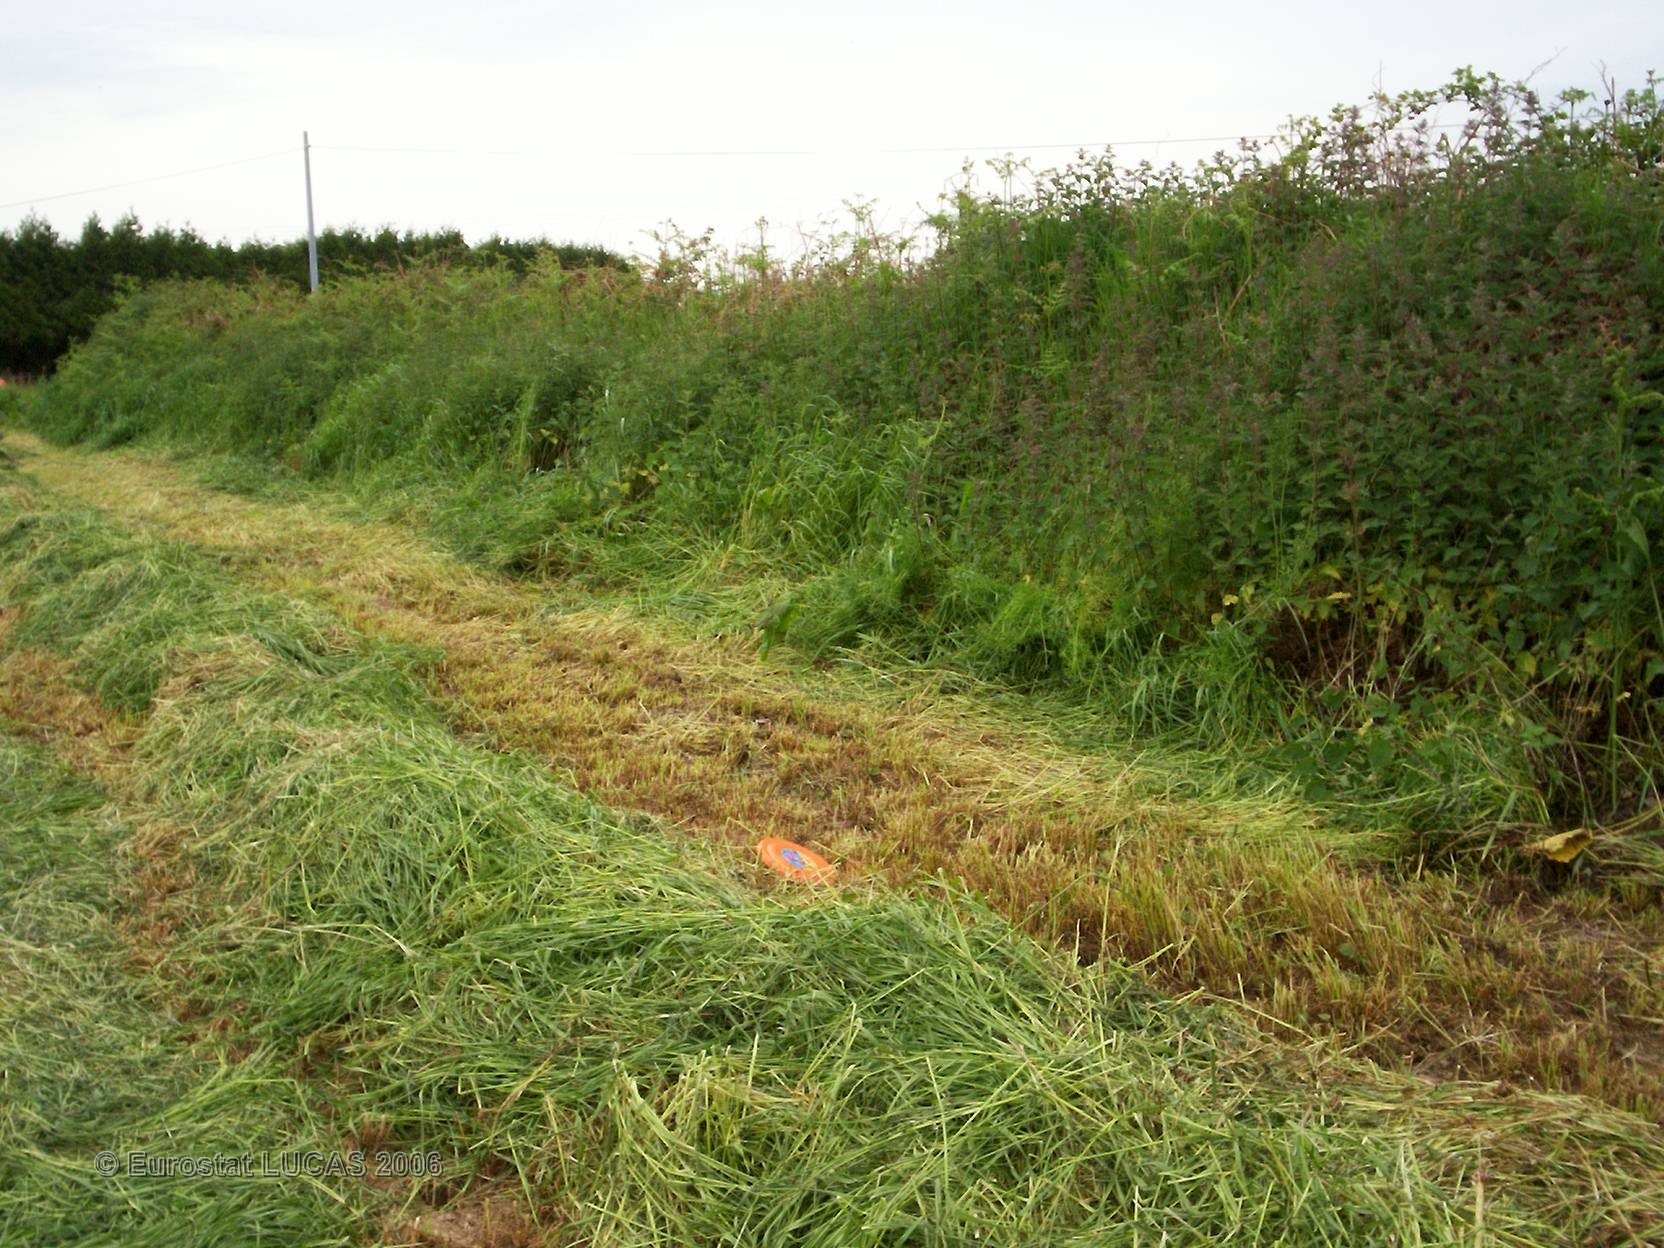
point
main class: Grassland
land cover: Grassland without tree/shrub cover
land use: Agriculture (excluding fallow land and kitchen gardens)
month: May
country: FR
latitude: 48.7514
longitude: -3.0887
